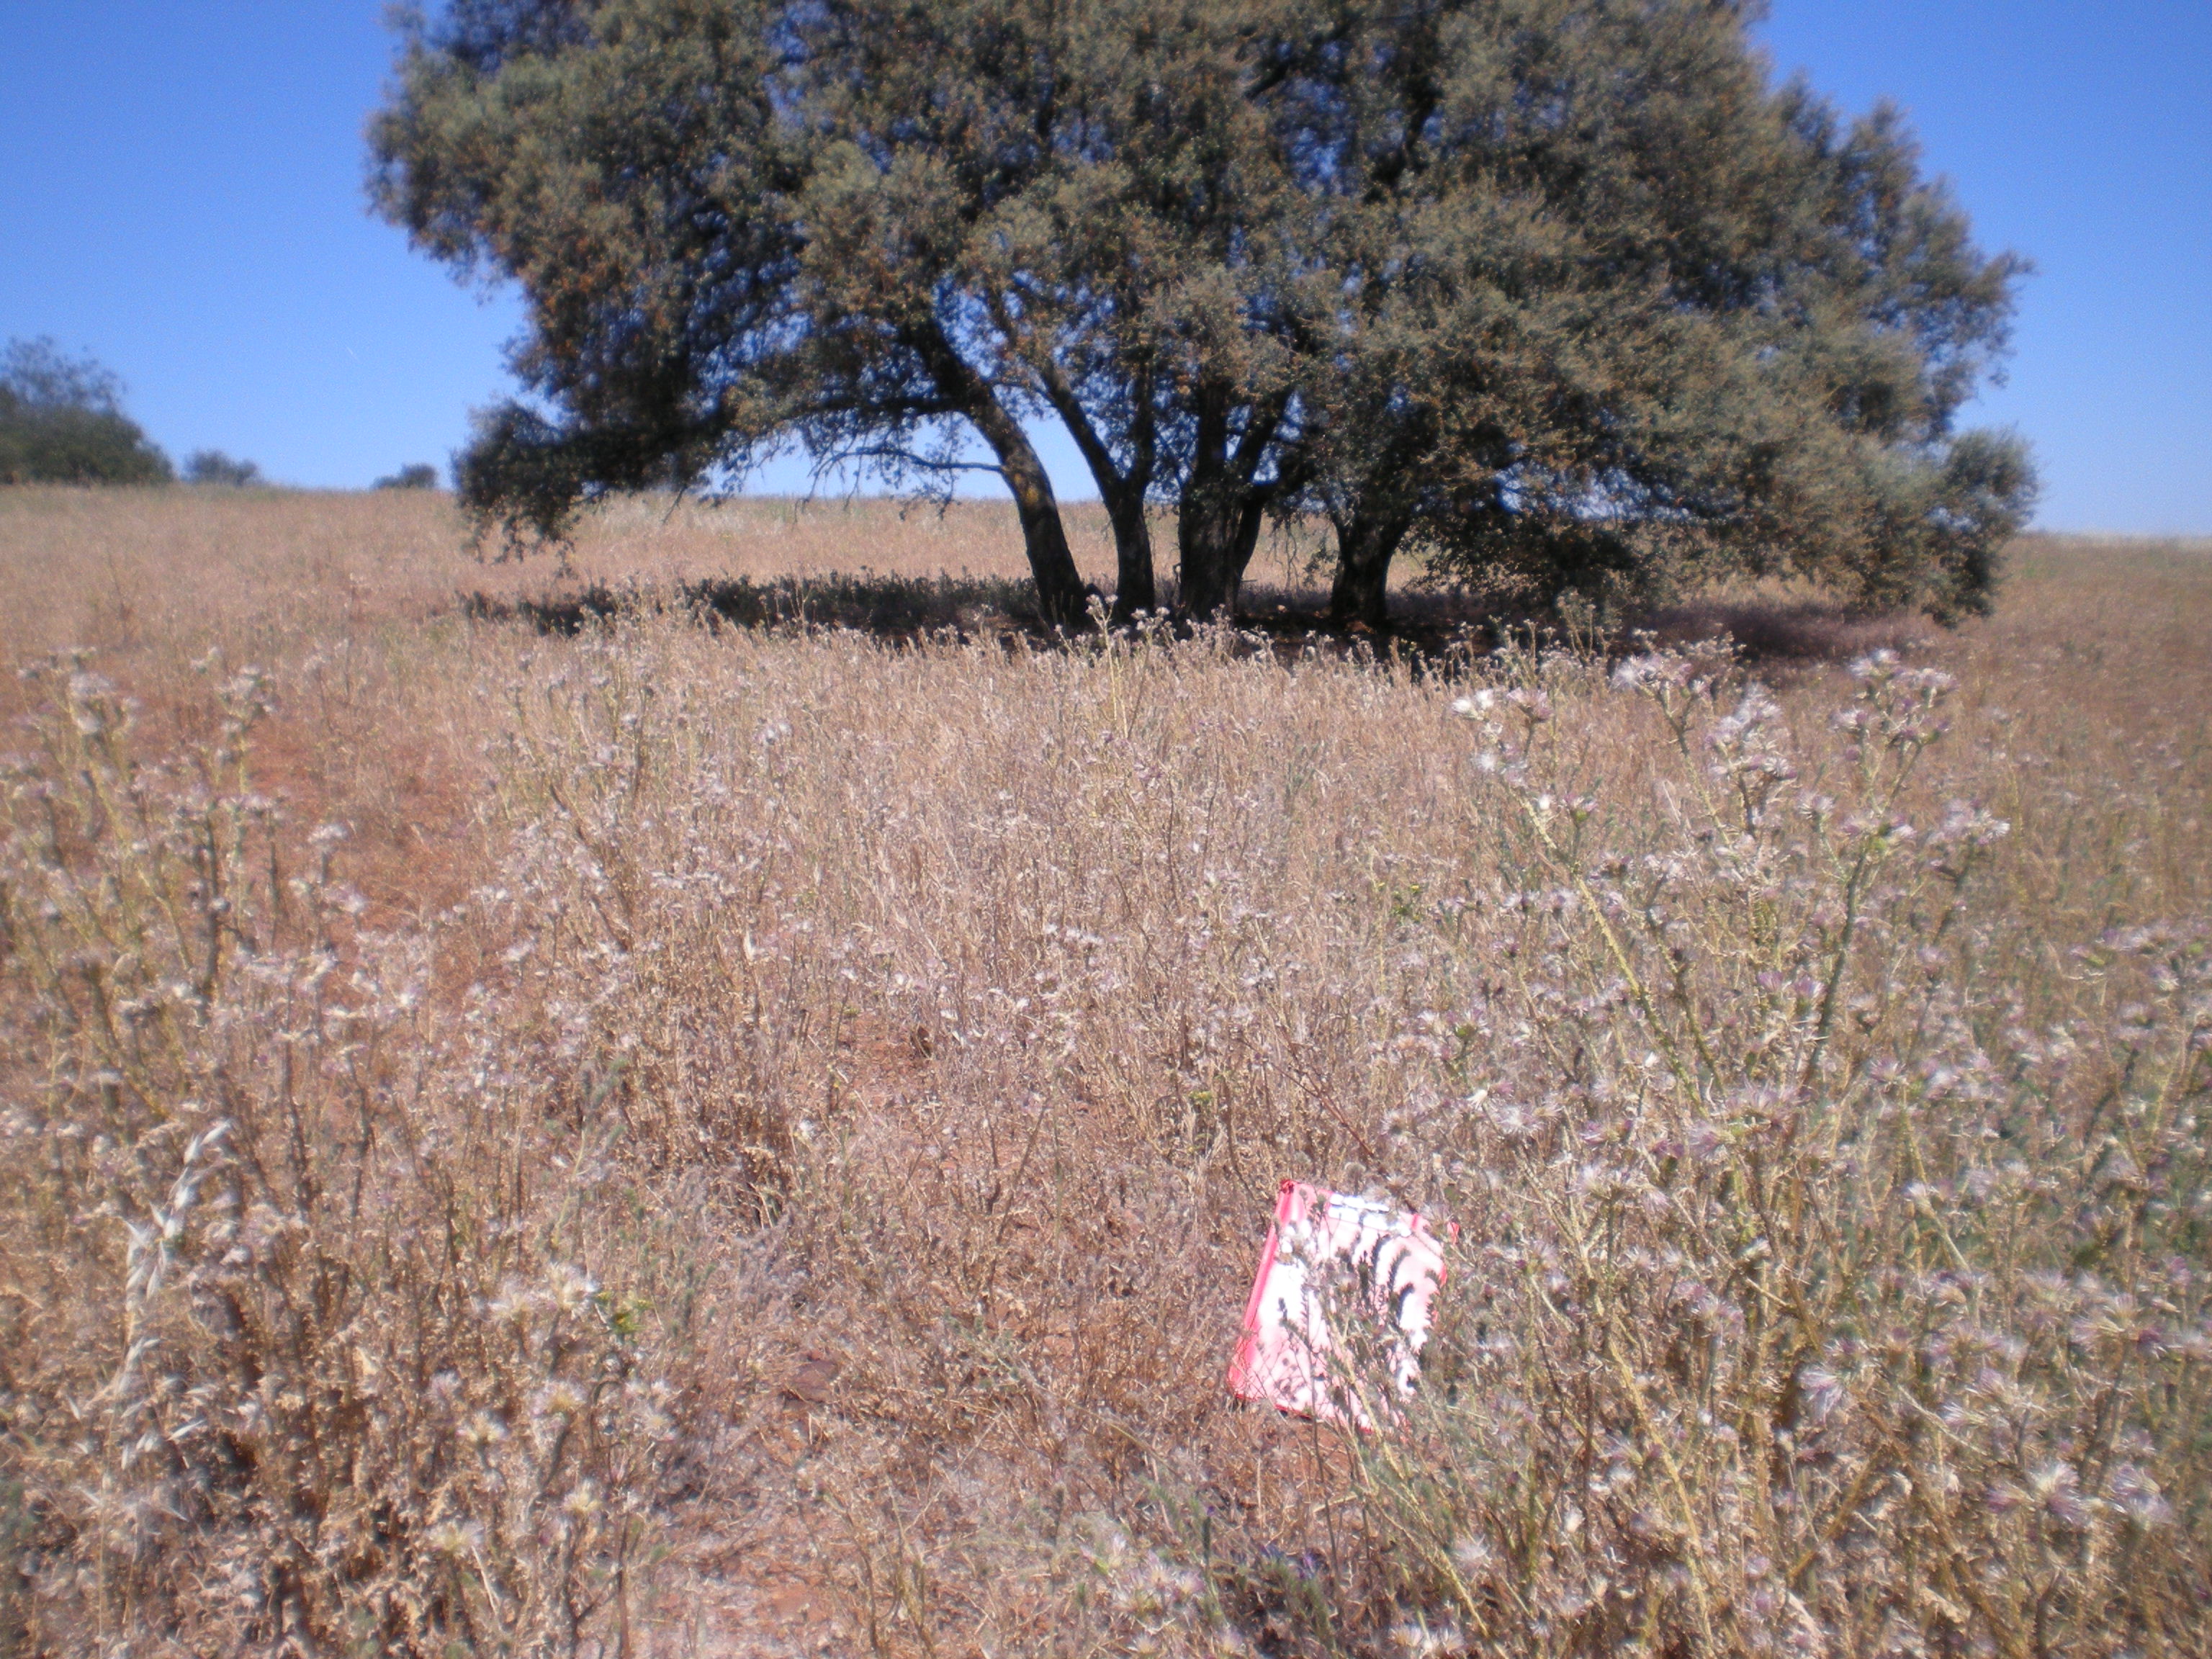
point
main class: Grassland
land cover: Grassland with sparse tree/shrub cover
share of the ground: > 75 %
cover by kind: unconsolidated bare surface 80 %, herbaceous plants 15 %, broadleaved forest trees 5 %
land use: Agriculture (excluding fallow land and kitchen gardens)
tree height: < 5 m
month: May
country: ES
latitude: 38.5136
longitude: -3.4377
